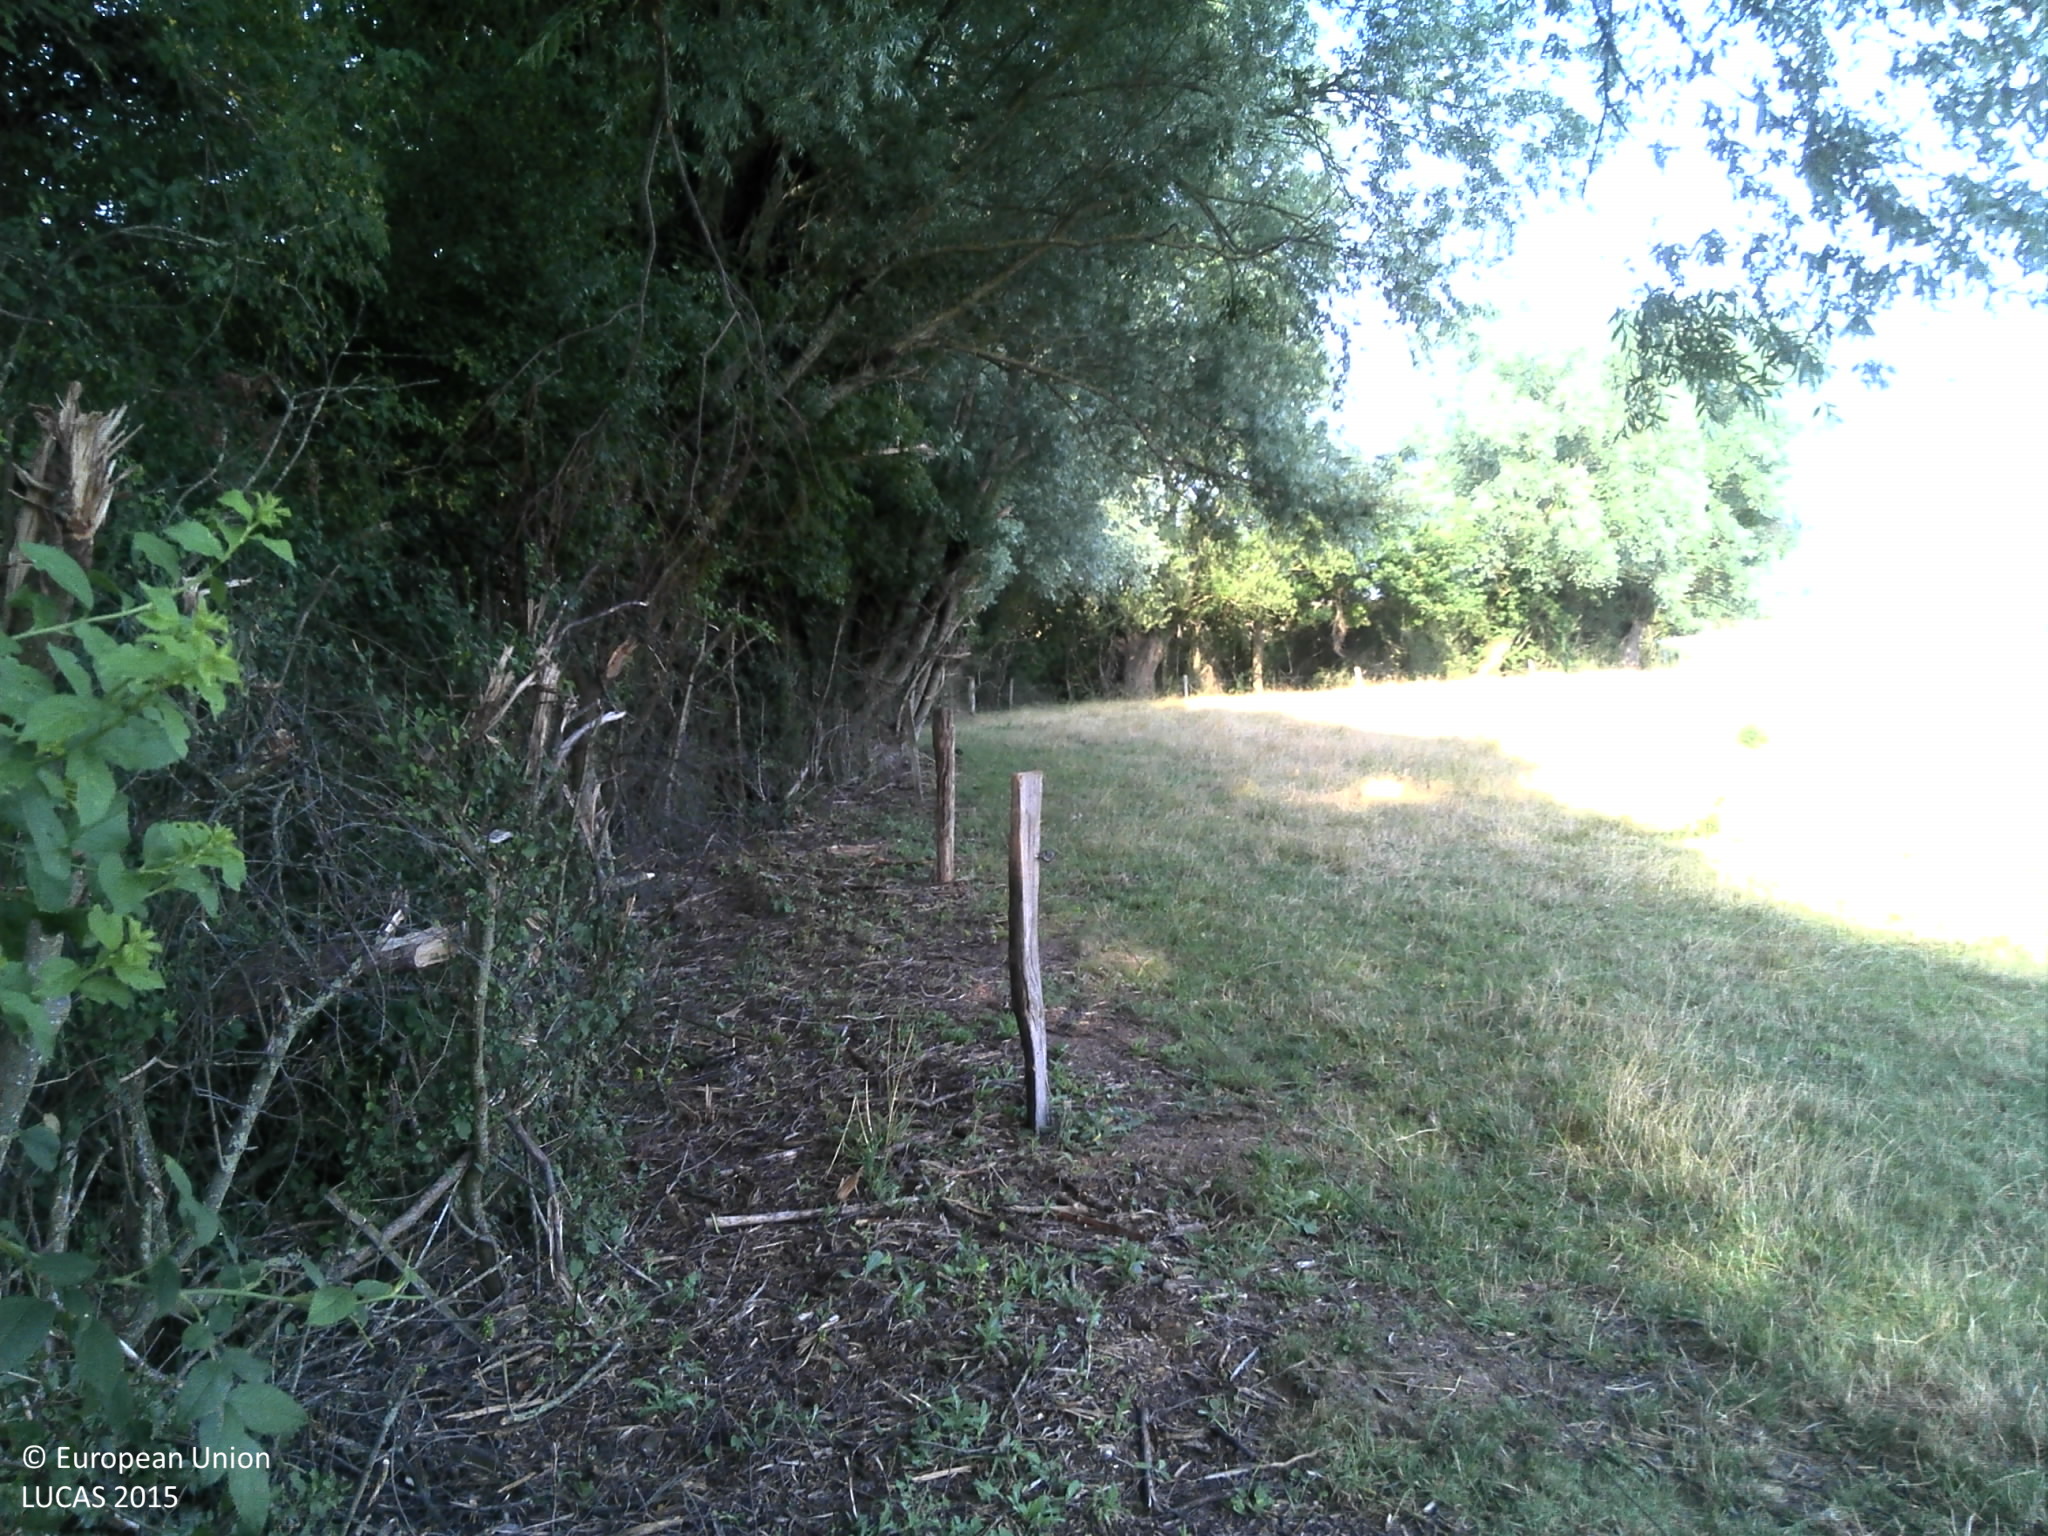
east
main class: Grassland
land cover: Grassland with sparse tree/shrub cover
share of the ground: > 75 %
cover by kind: herbaceous plants 95 %, broadleaved forest trees 5 %
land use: Agriculture (excluding fallow land and kitchen gardens)
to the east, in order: Grassland with sparse tree/shrub cover; Grassland without tree/shrub cover; Fences; Lines of trees; Grassland without tree/shrub cover; Rivers and streams; Grassland without tree/shrub cover; Electric lines; Railways; Electric lines; Grassland without tree/shrub cover; Paved roads, cycling and walking lanes; Grassland without tree/shrub cover; Fences; Grassland without tree/shrub cover
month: July
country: FR
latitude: 48.8613
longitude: 6.7971
